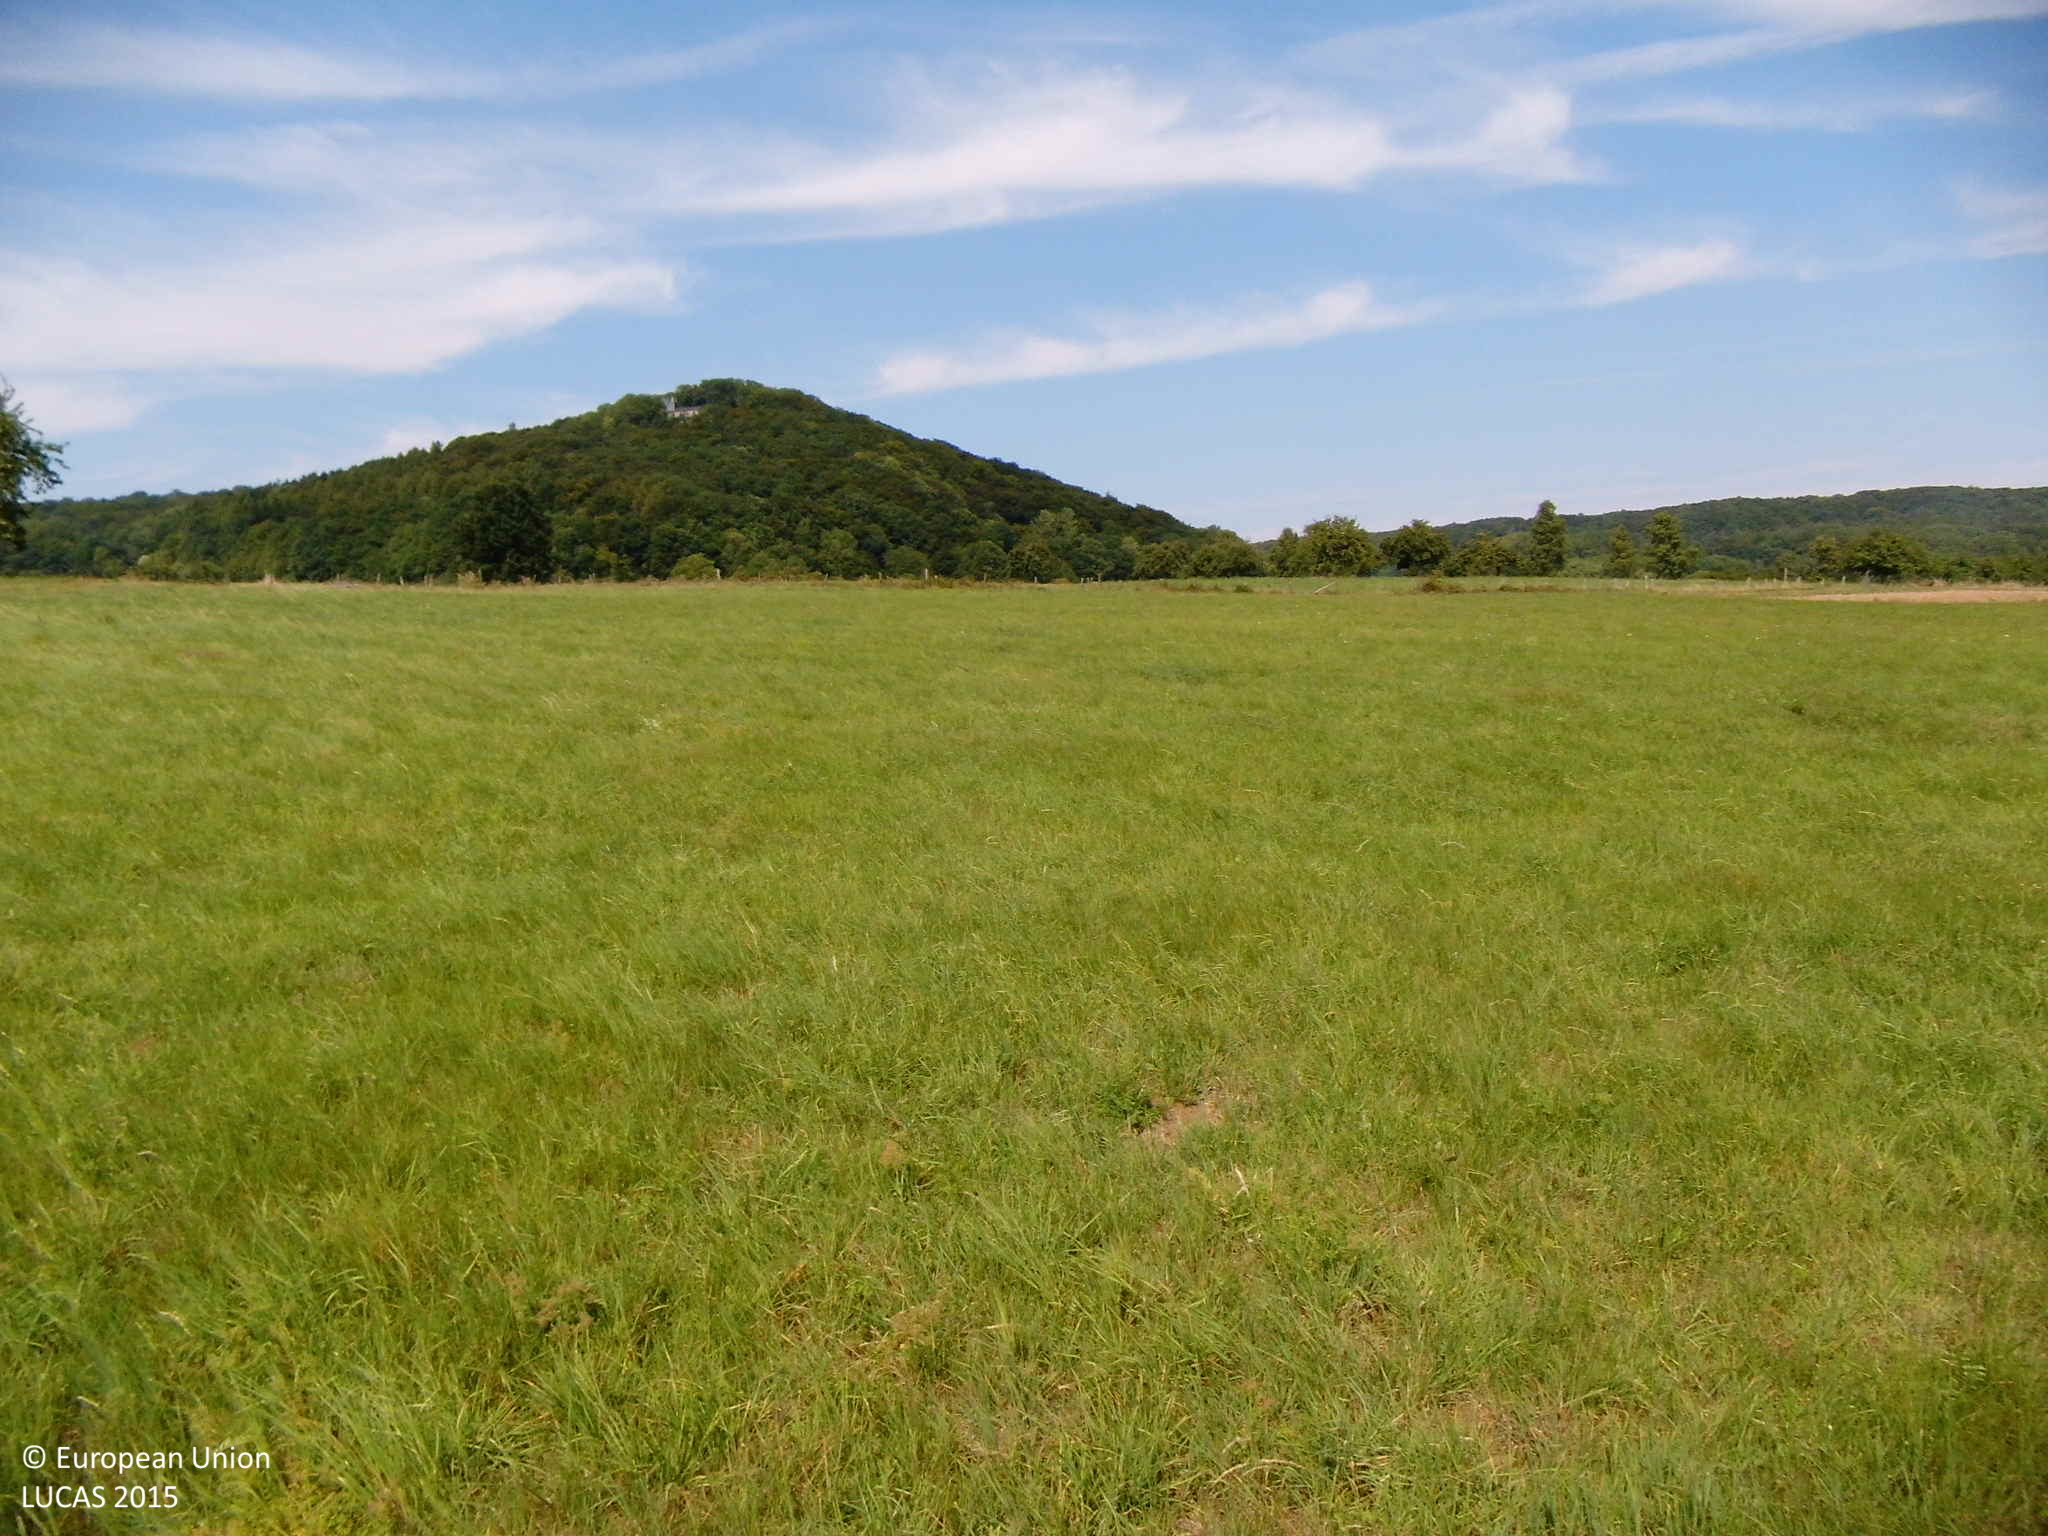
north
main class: Grassland
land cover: Grassland without tree/shrub cover
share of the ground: > 75 %
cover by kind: herbaceous plants 95 %, unconsolidated bare surface 5 %
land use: Agriculture (excluding fallow land and kitchen gardens)
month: August
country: DE
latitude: 50.5087
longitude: 8.0121
